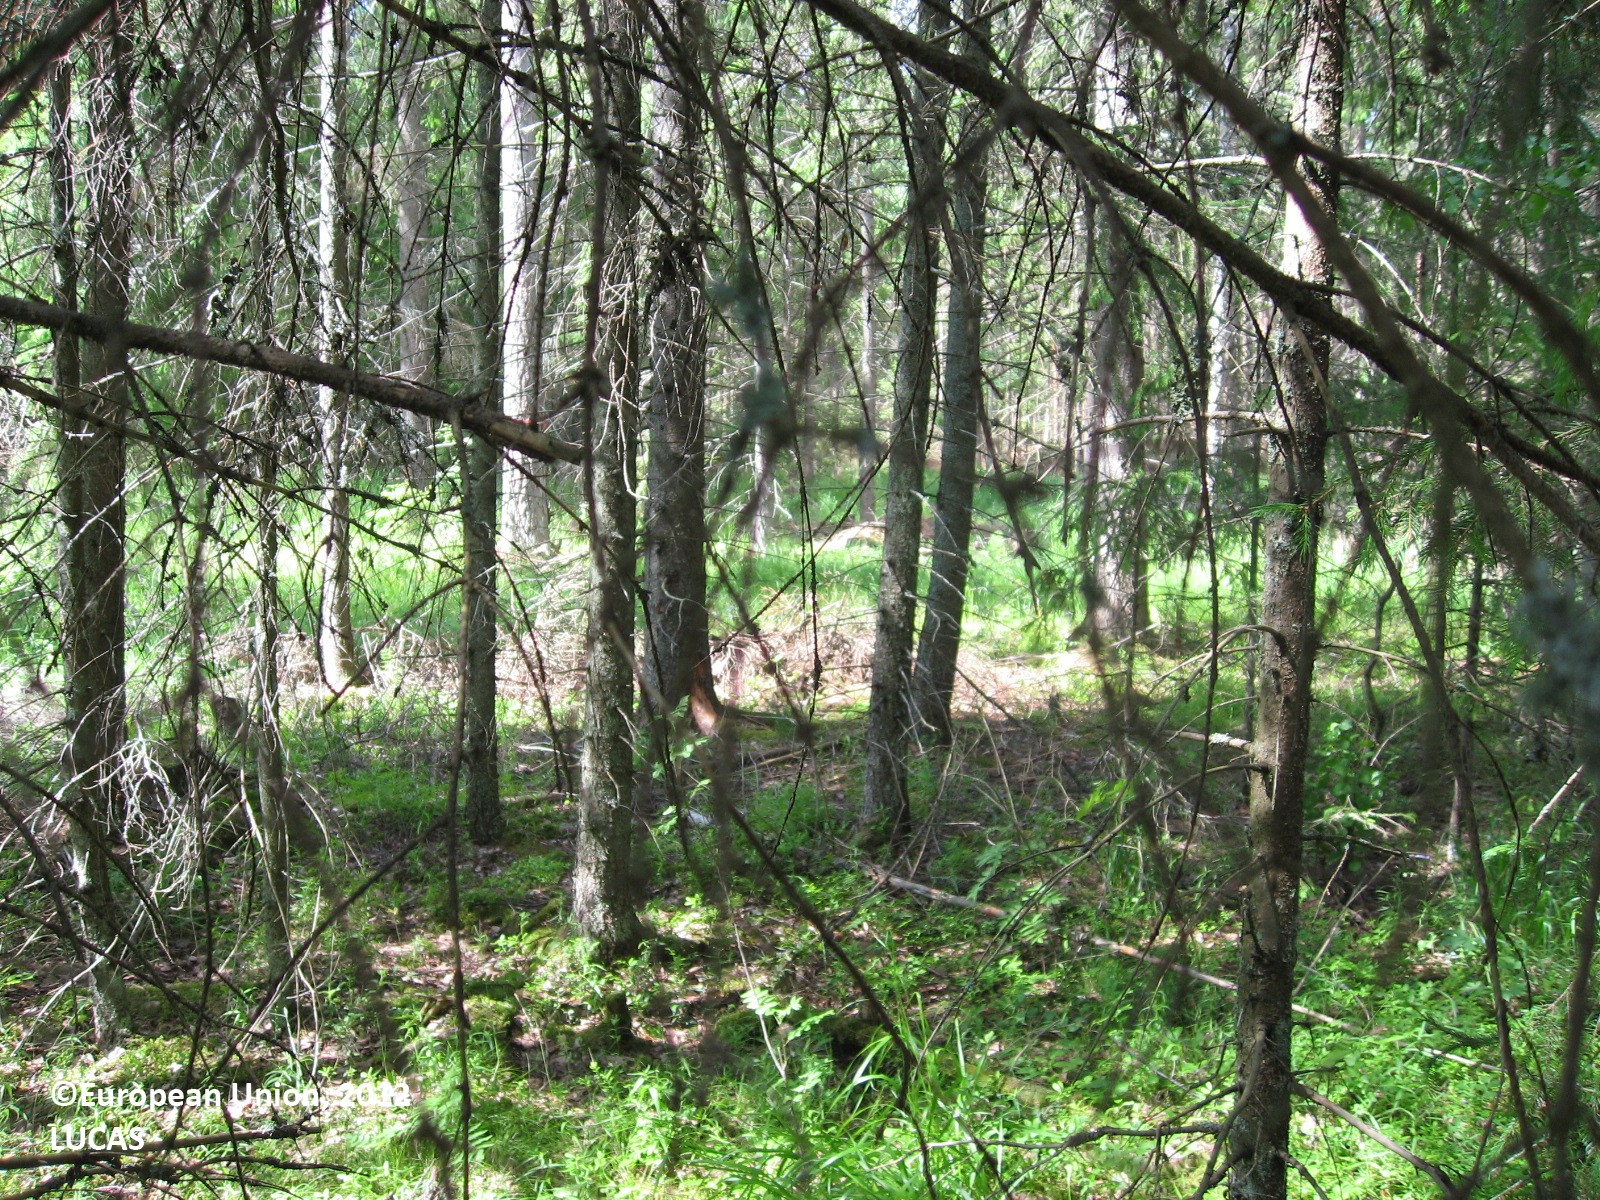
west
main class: Woodland
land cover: Spruce dominated mixed woodland
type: boreal forest
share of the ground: > 75 %
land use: Forestry
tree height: > 5 m
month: June
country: FI
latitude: 60.6452
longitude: 26.5980
